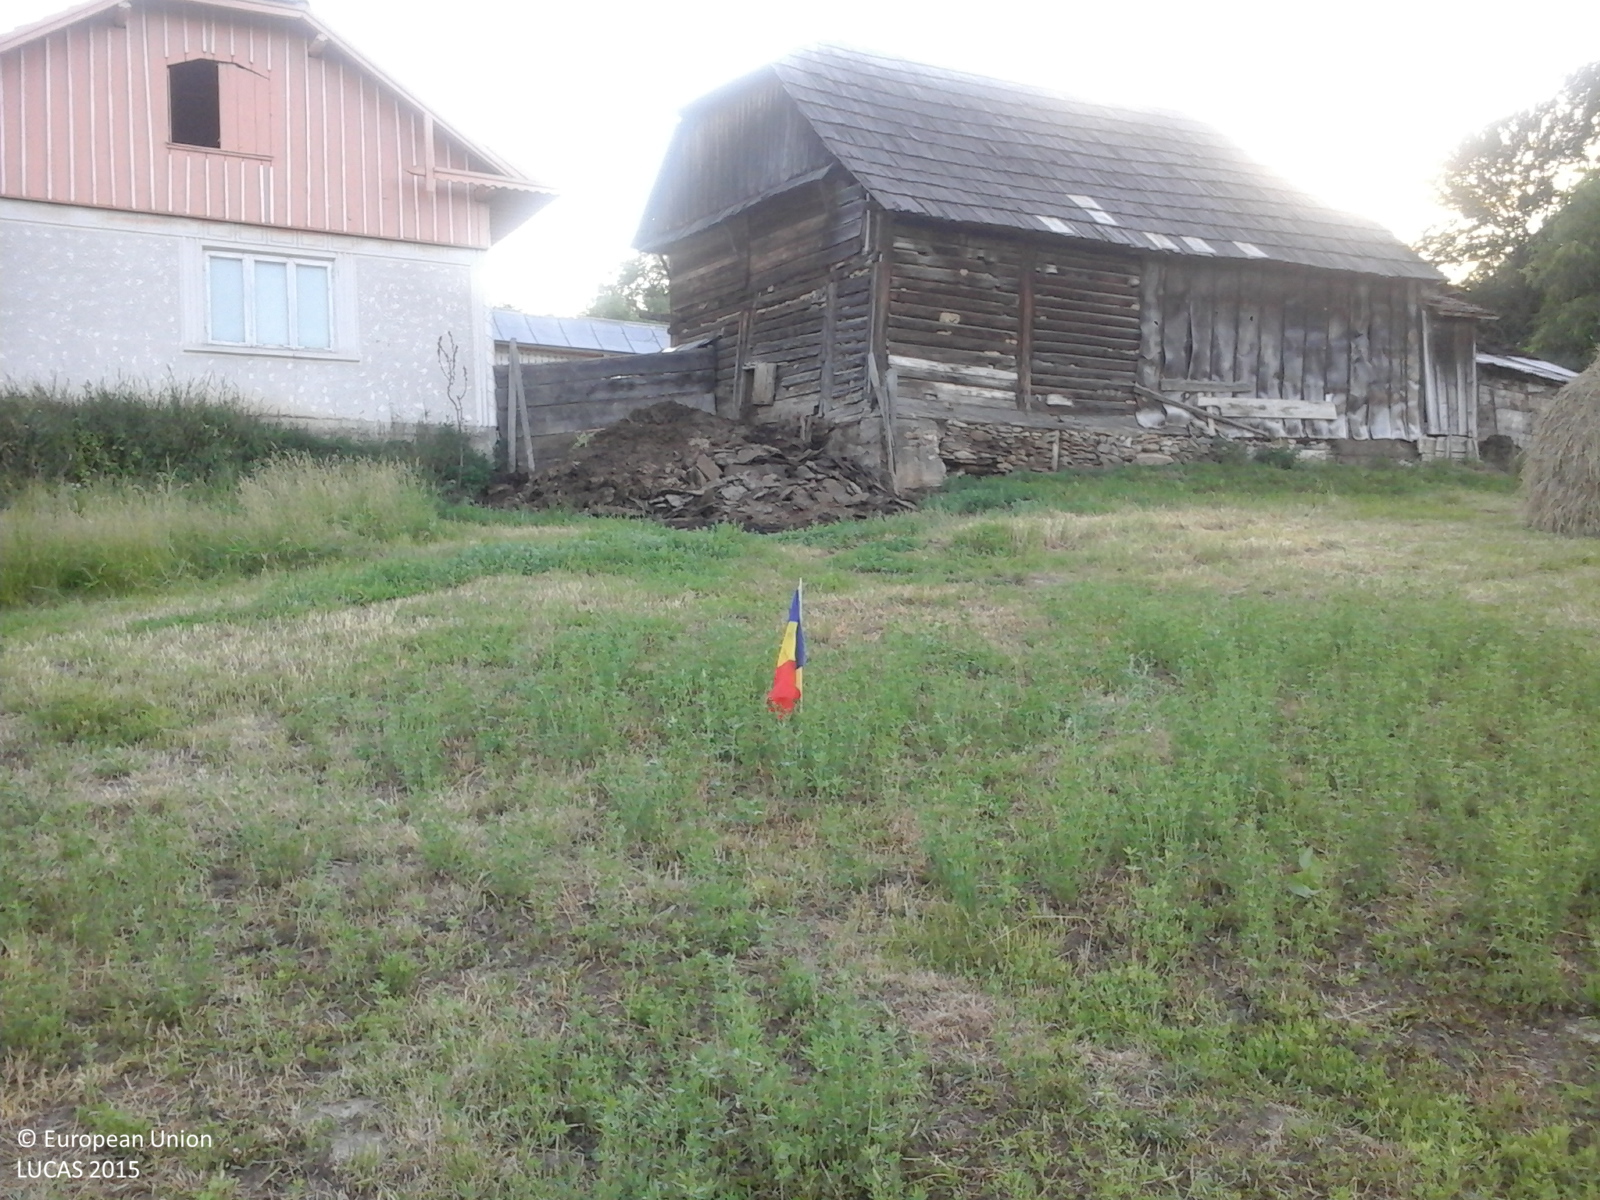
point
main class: Cropland
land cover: Lucerne
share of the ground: 25 - 50 %
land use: Agriculture (excluding fallow land and kitchen gardens)
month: June
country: RO
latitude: 47.6775
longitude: 25.9392
